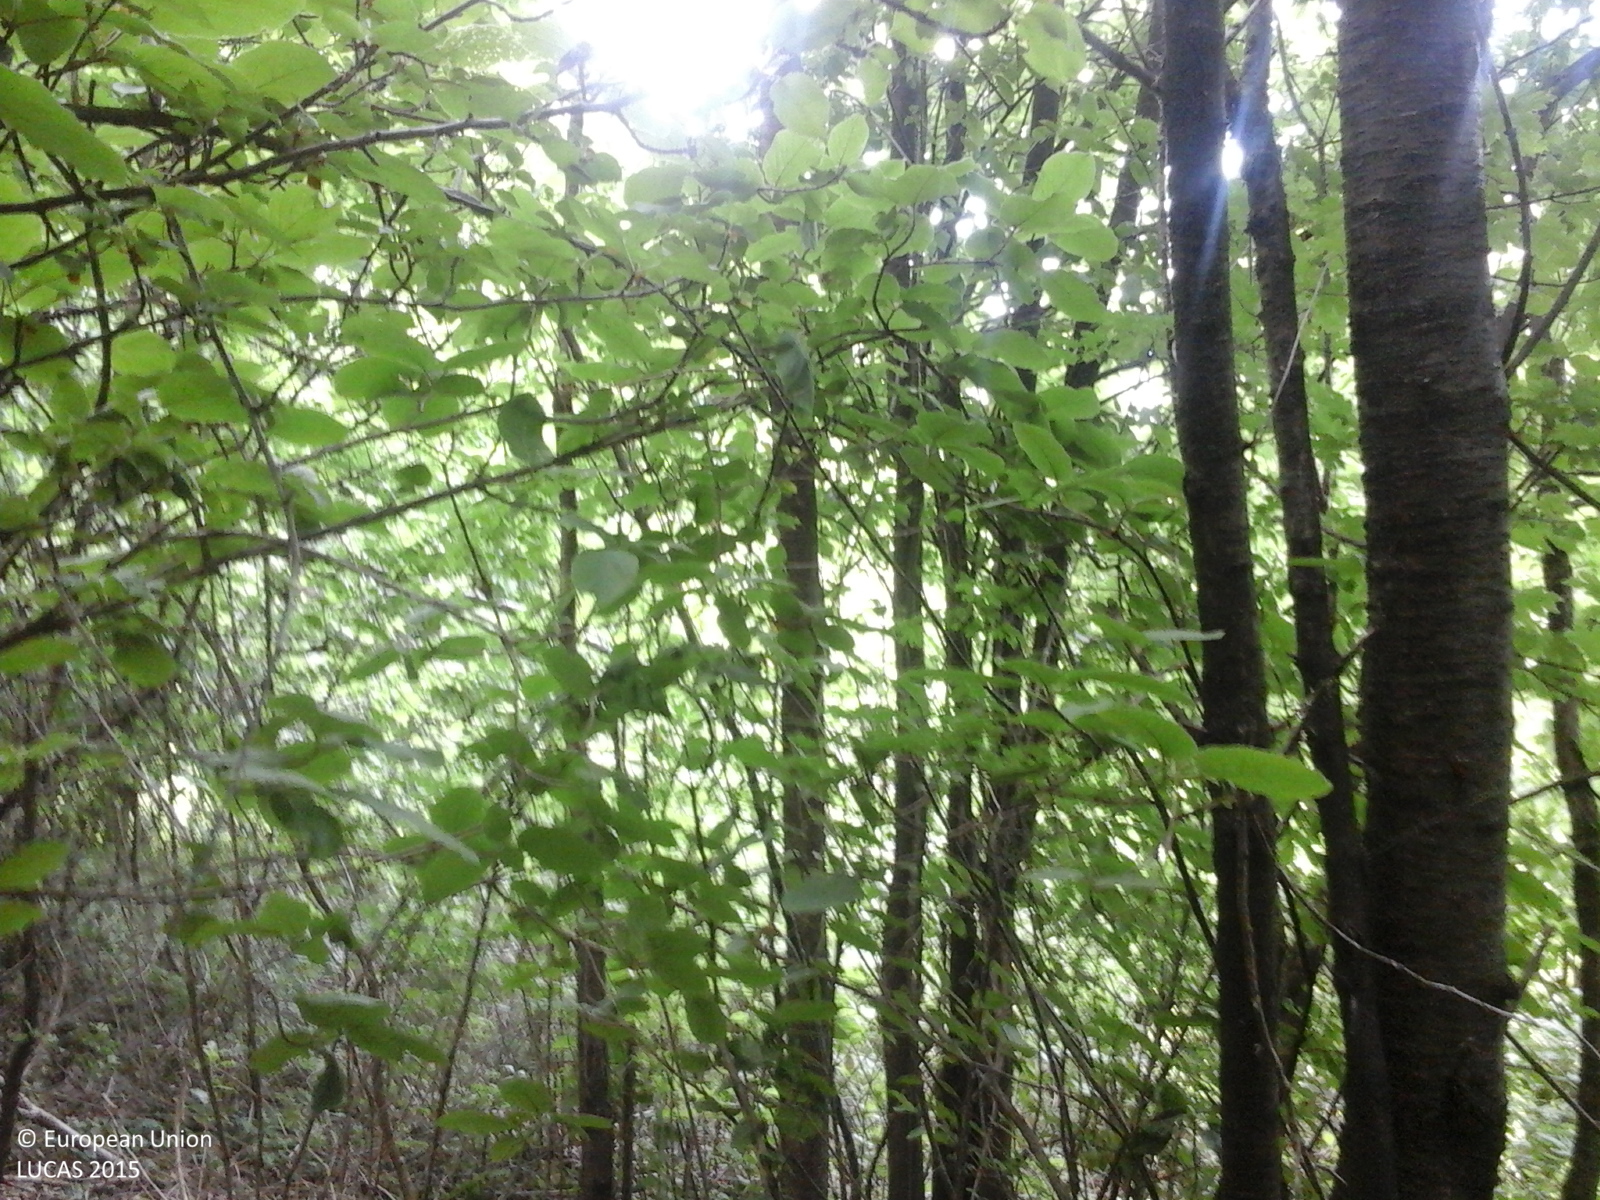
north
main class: Woodland
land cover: Broadleaved woodland
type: beech forest
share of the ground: > 75 %
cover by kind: broadleaved forest trees 100 %
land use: Forestry
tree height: > 5 m
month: June
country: RO
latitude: 46.5316
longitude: 26.7112
